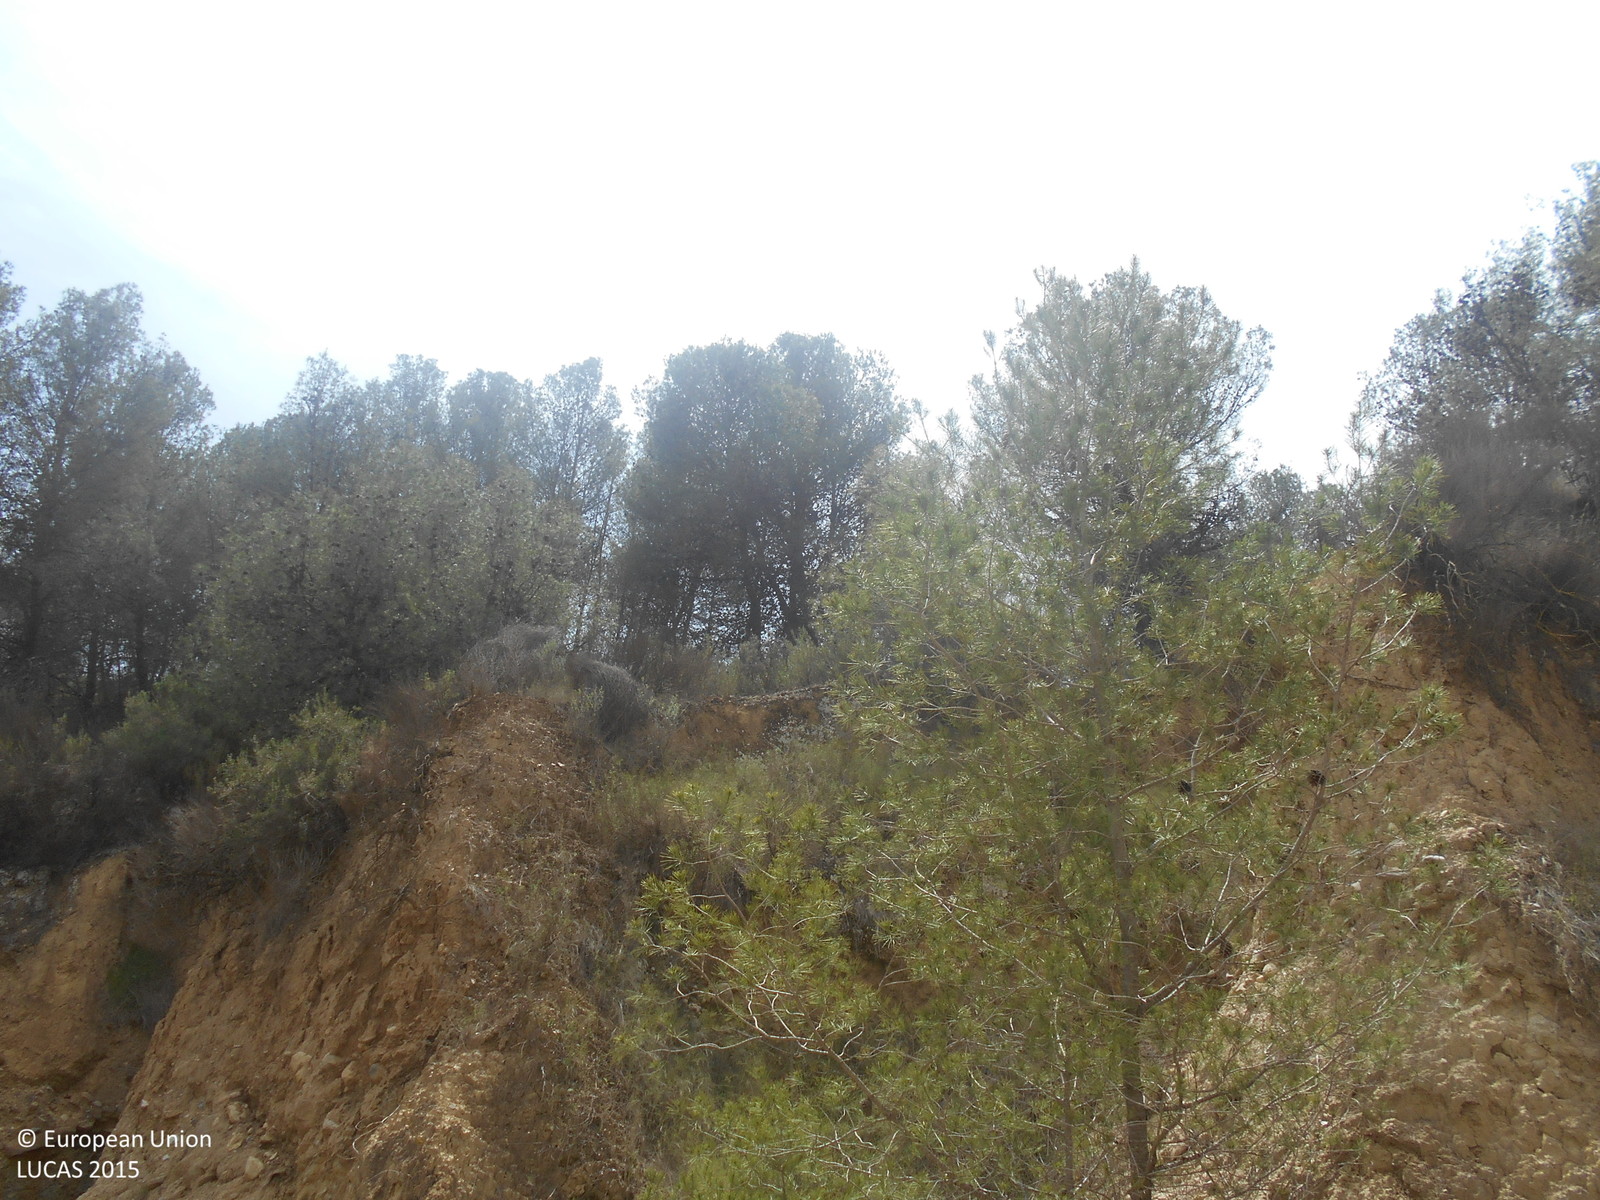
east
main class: Woodland
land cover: Pine dominated coniferous woodland
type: coniferous forest of the mediterranean region
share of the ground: 10 - 25 %
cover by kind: unconsolidated bare surface 40 %, shrubs 30 %, coniferous forest trees 20 %, consolidated bare surface 10 %
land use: Semi-natural and natural areas not in use
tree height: > 5 m
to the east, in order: Pine dominated coniferous woodland; Shrubland with sparse tree cover; Pine dominated coniferous woodland
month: April
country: ES
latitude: 37.6503
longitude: -1.5083
